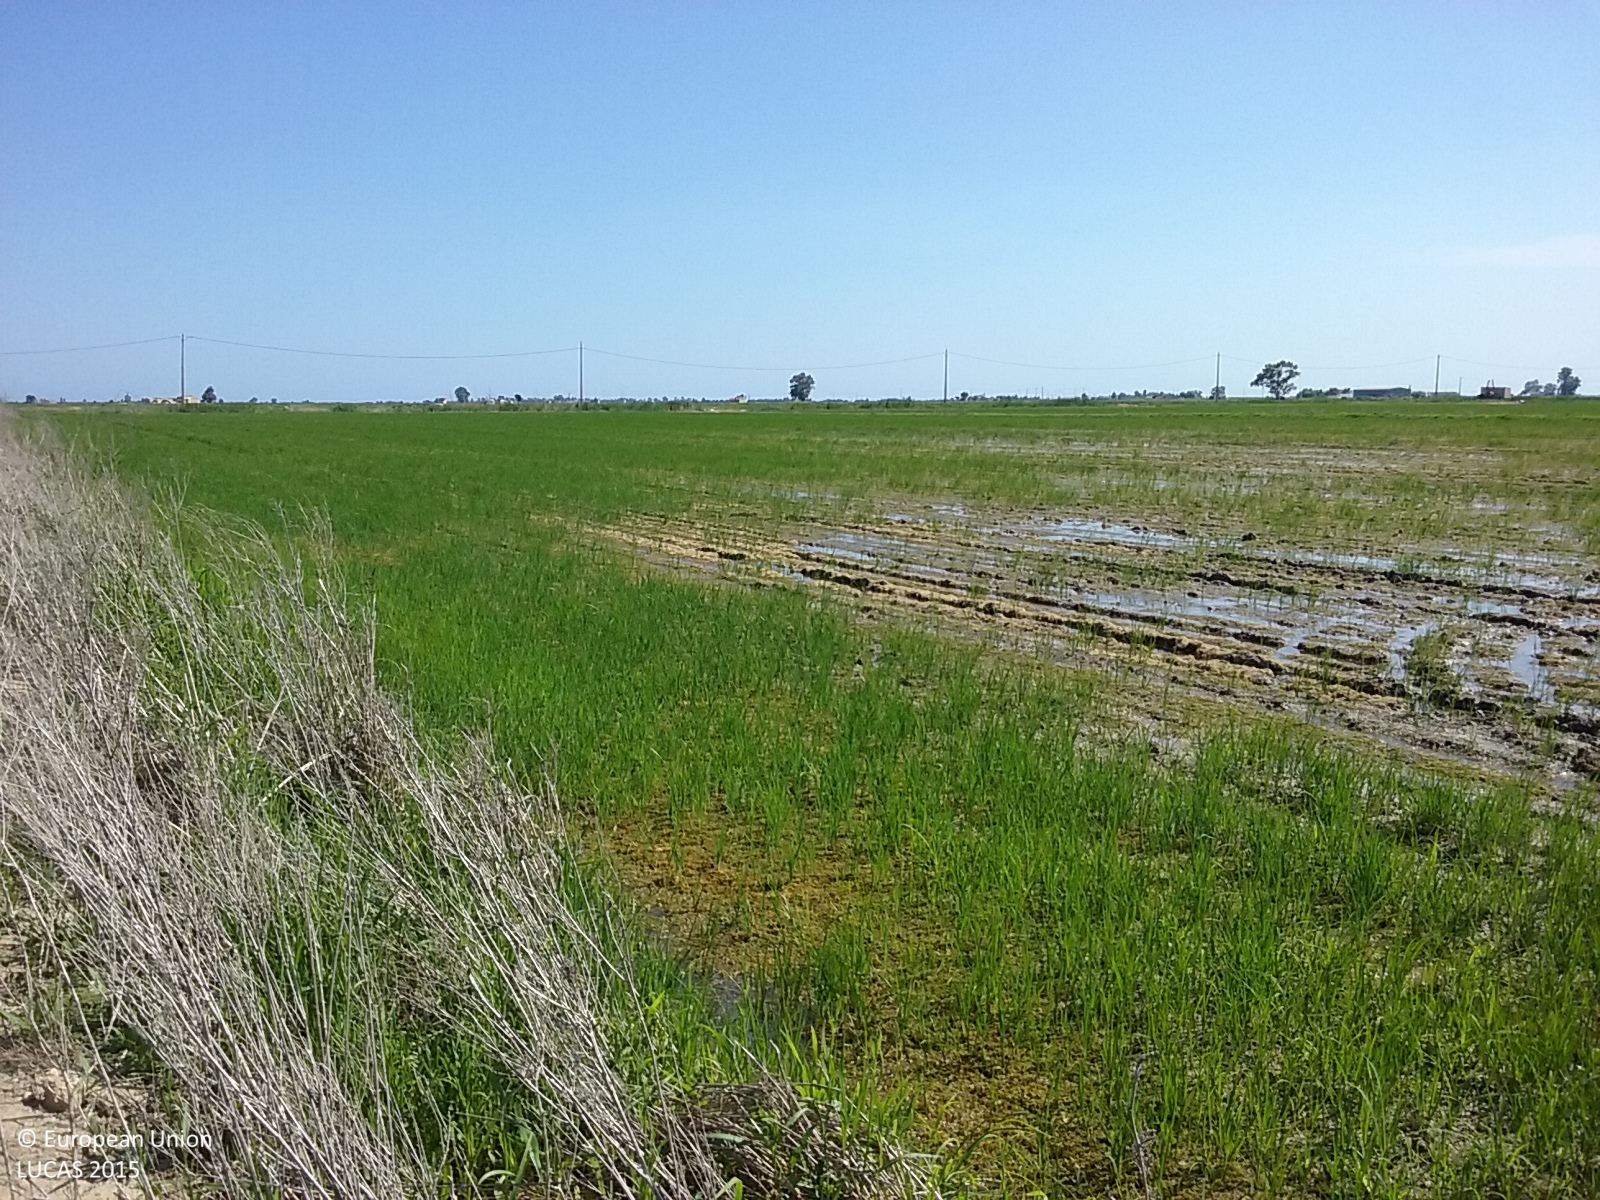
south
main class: Cropland
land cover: Rice
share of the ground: 50 - 75 %
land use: Agriculture (excluding fallow land and kitchen gardens)
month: June
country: ES
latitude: 40.6785
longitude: 0.6845
